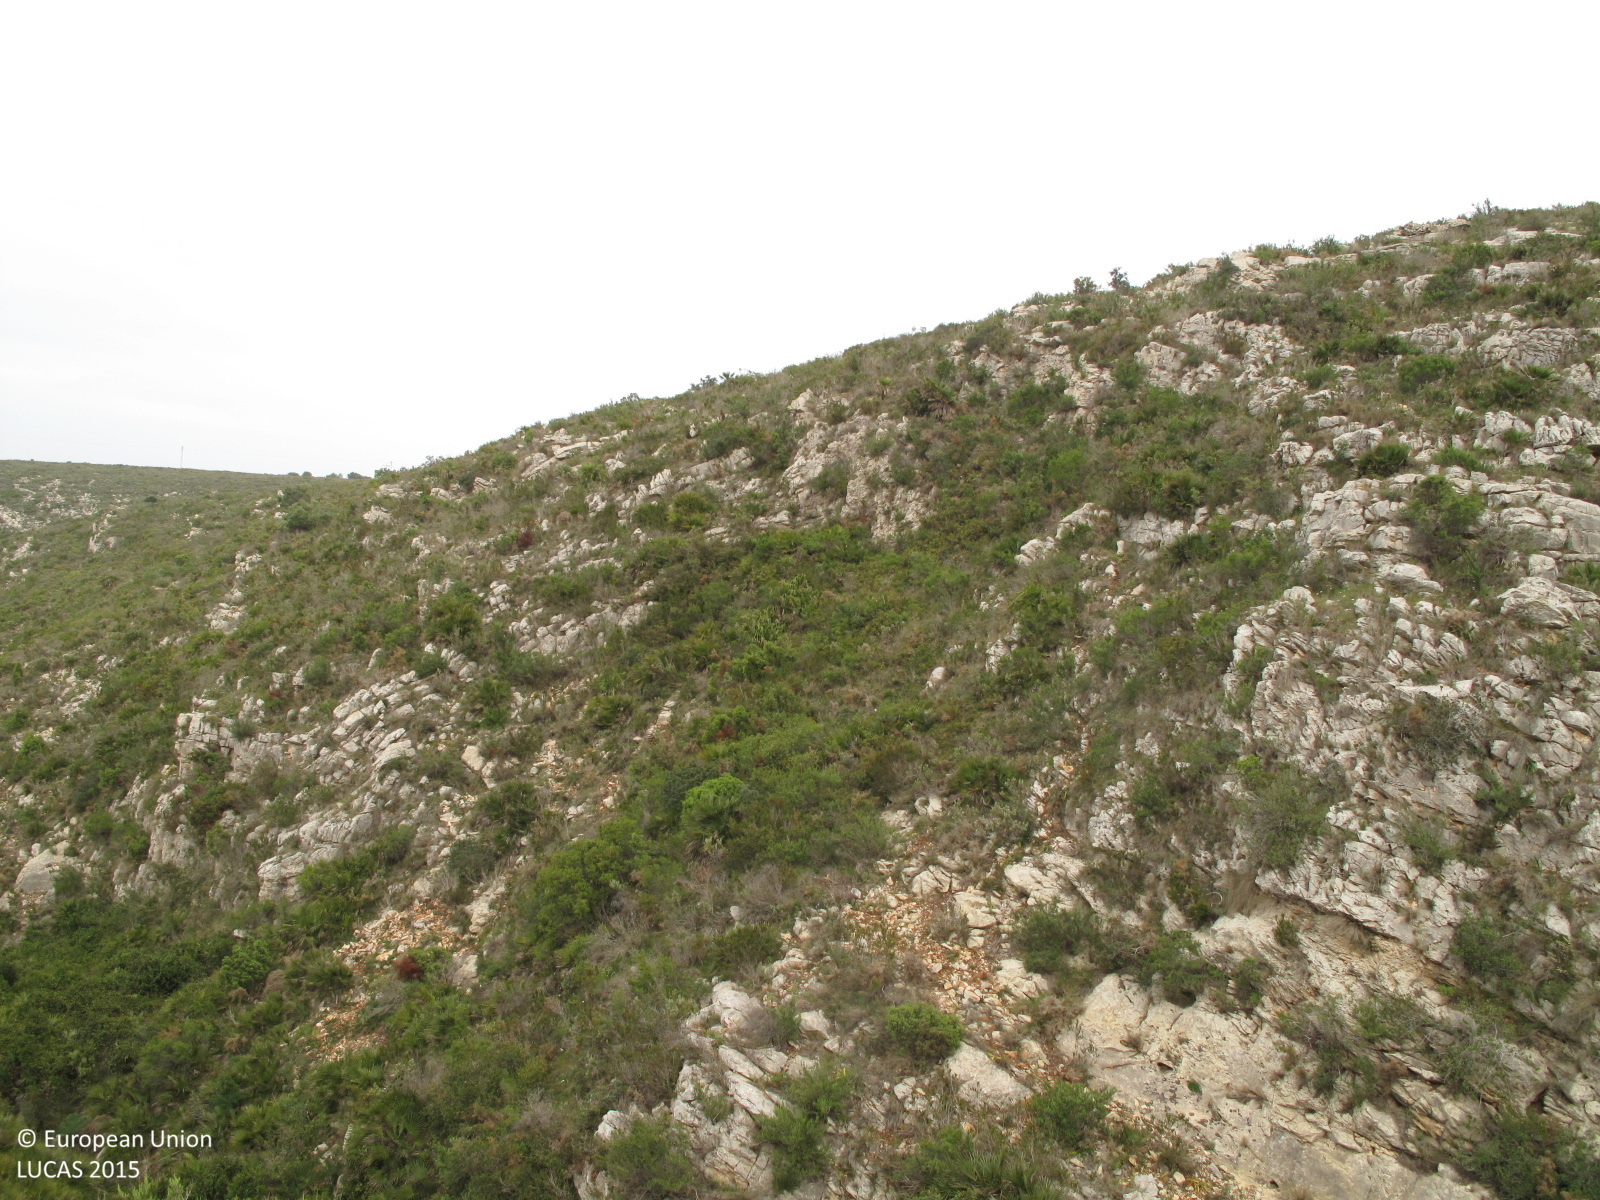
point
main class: Shrubland
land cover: Shrubland without tree cover
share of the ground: 25 - 50 %
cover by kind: shrubs 40 %, consolidated bare surface 40 %, herbaceous plants 20 %
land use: Semi-natural and natural areas not in use
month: April
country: ES
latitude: 38.8037
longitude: 0.1433
